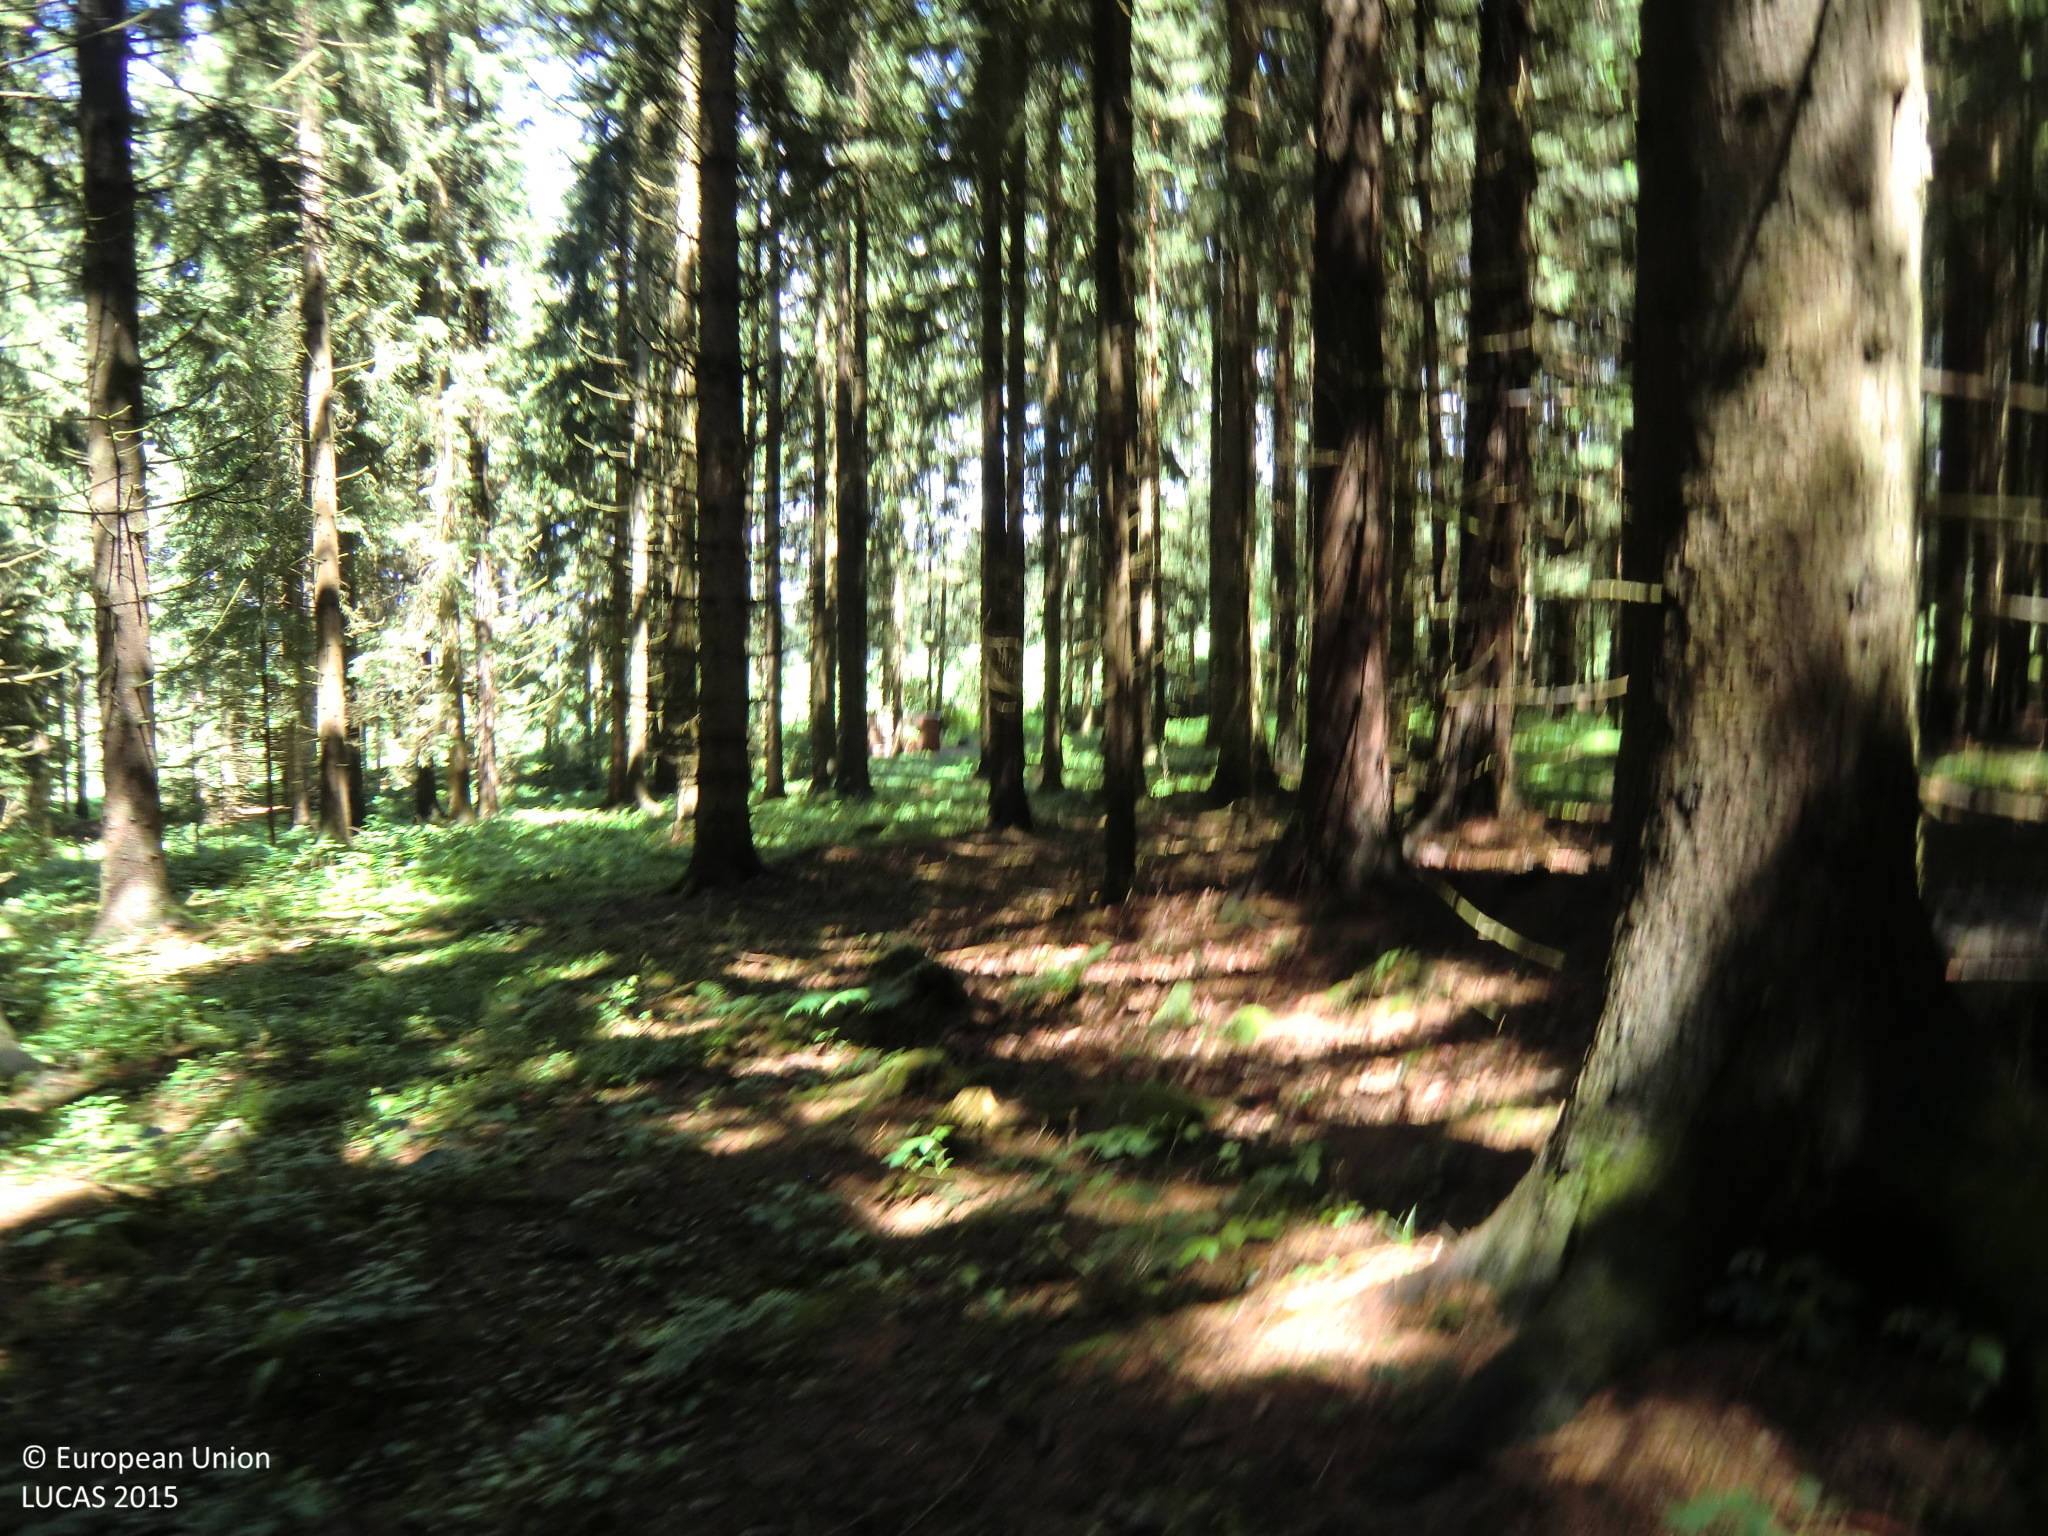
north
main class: Woodland
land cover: Spruce dominated coniferous woodland
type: hemiboreal forest and nemoral coniferous forest and mixed broadleaved-coniferous forest
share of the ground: > 75 %
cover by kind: coniferous forest trees 90 %, herbaceous plants 5 %, unconsolidated bare surface 5 %
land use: Forestry
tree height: > 5 m
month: June
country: AT
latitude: 48.5603
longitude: 14.5943
